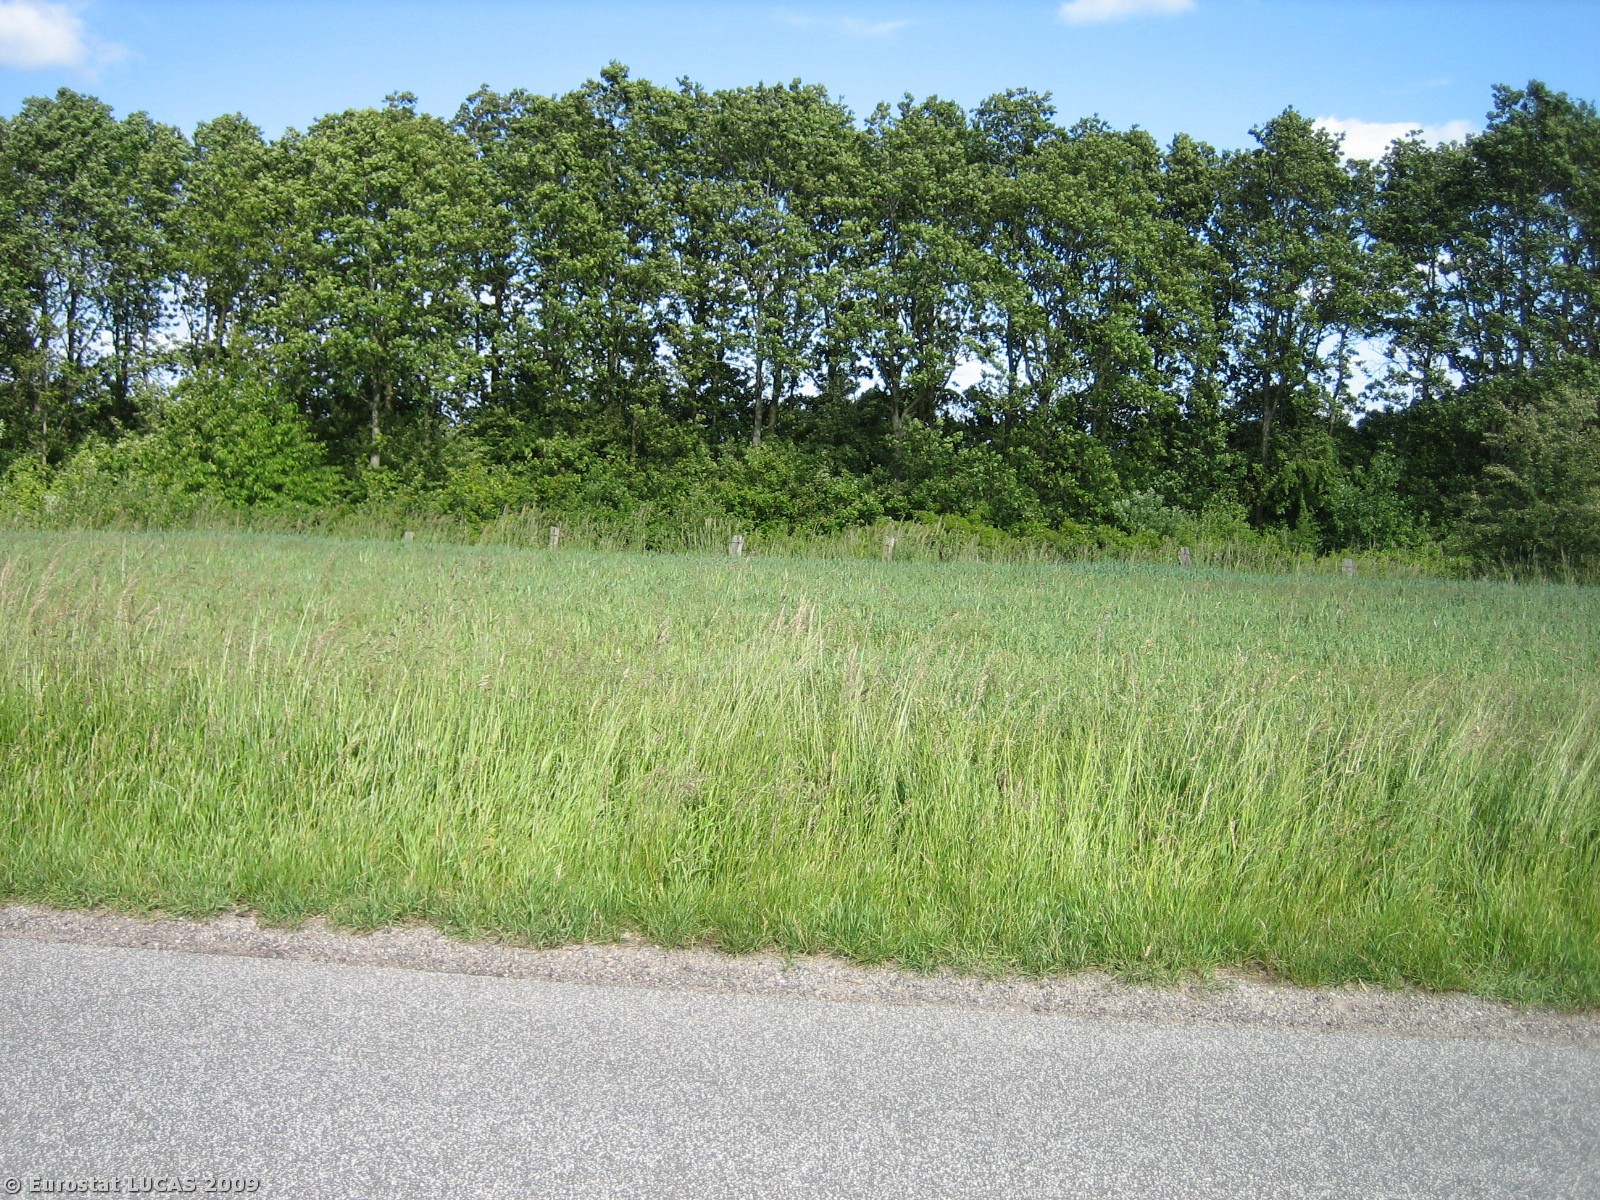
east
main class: Grassland
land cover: Grassland without tree/shrub cover
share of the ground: > 75 %
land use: Unused
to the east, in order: Grassland without tree/shrub cover; Paved roads, cycling and walking lanes; Grassland without tree/shrub cover; Fences; Shrubland without tree cover; Railways; Shrubland with sparse tree cover; Broadleaved woodland; Oats; Grass margins; Paved roads, cycling and walking lanes; Grassland without tree/shrub cover; Tracks
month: June
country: DK
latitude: 55.7560
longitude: 9.6976
